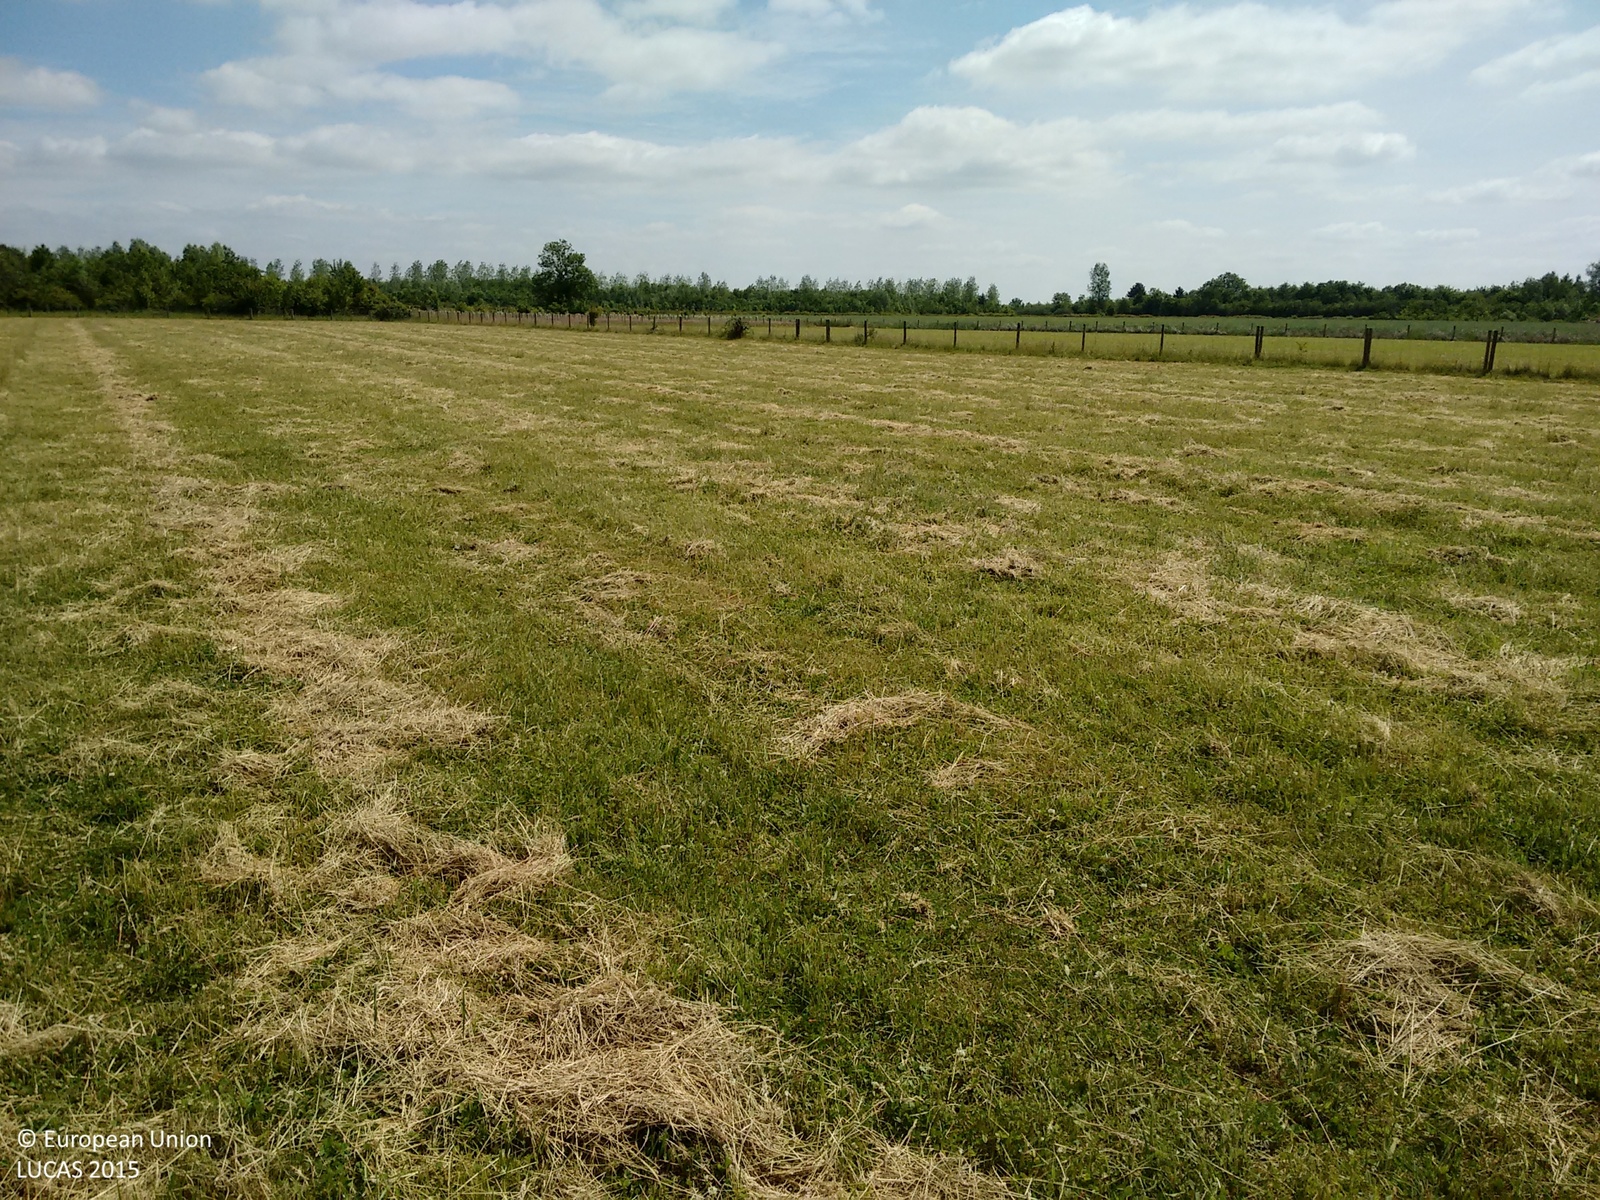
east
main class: Grassland
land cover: Grassland without tree/shrub cover
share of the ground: > 75 %
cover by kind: herbaceous plants 100 %
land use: Agriculture (excluding fallow land and kitchen gardens)
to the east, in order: Grassland without tree/shrub cover; Fences; Grassland without tree/shrub cover; Fences; Rape and turnip rape; Grass margins; Tracks
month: June
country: GB
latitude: 51.8679
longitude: -1.1566
